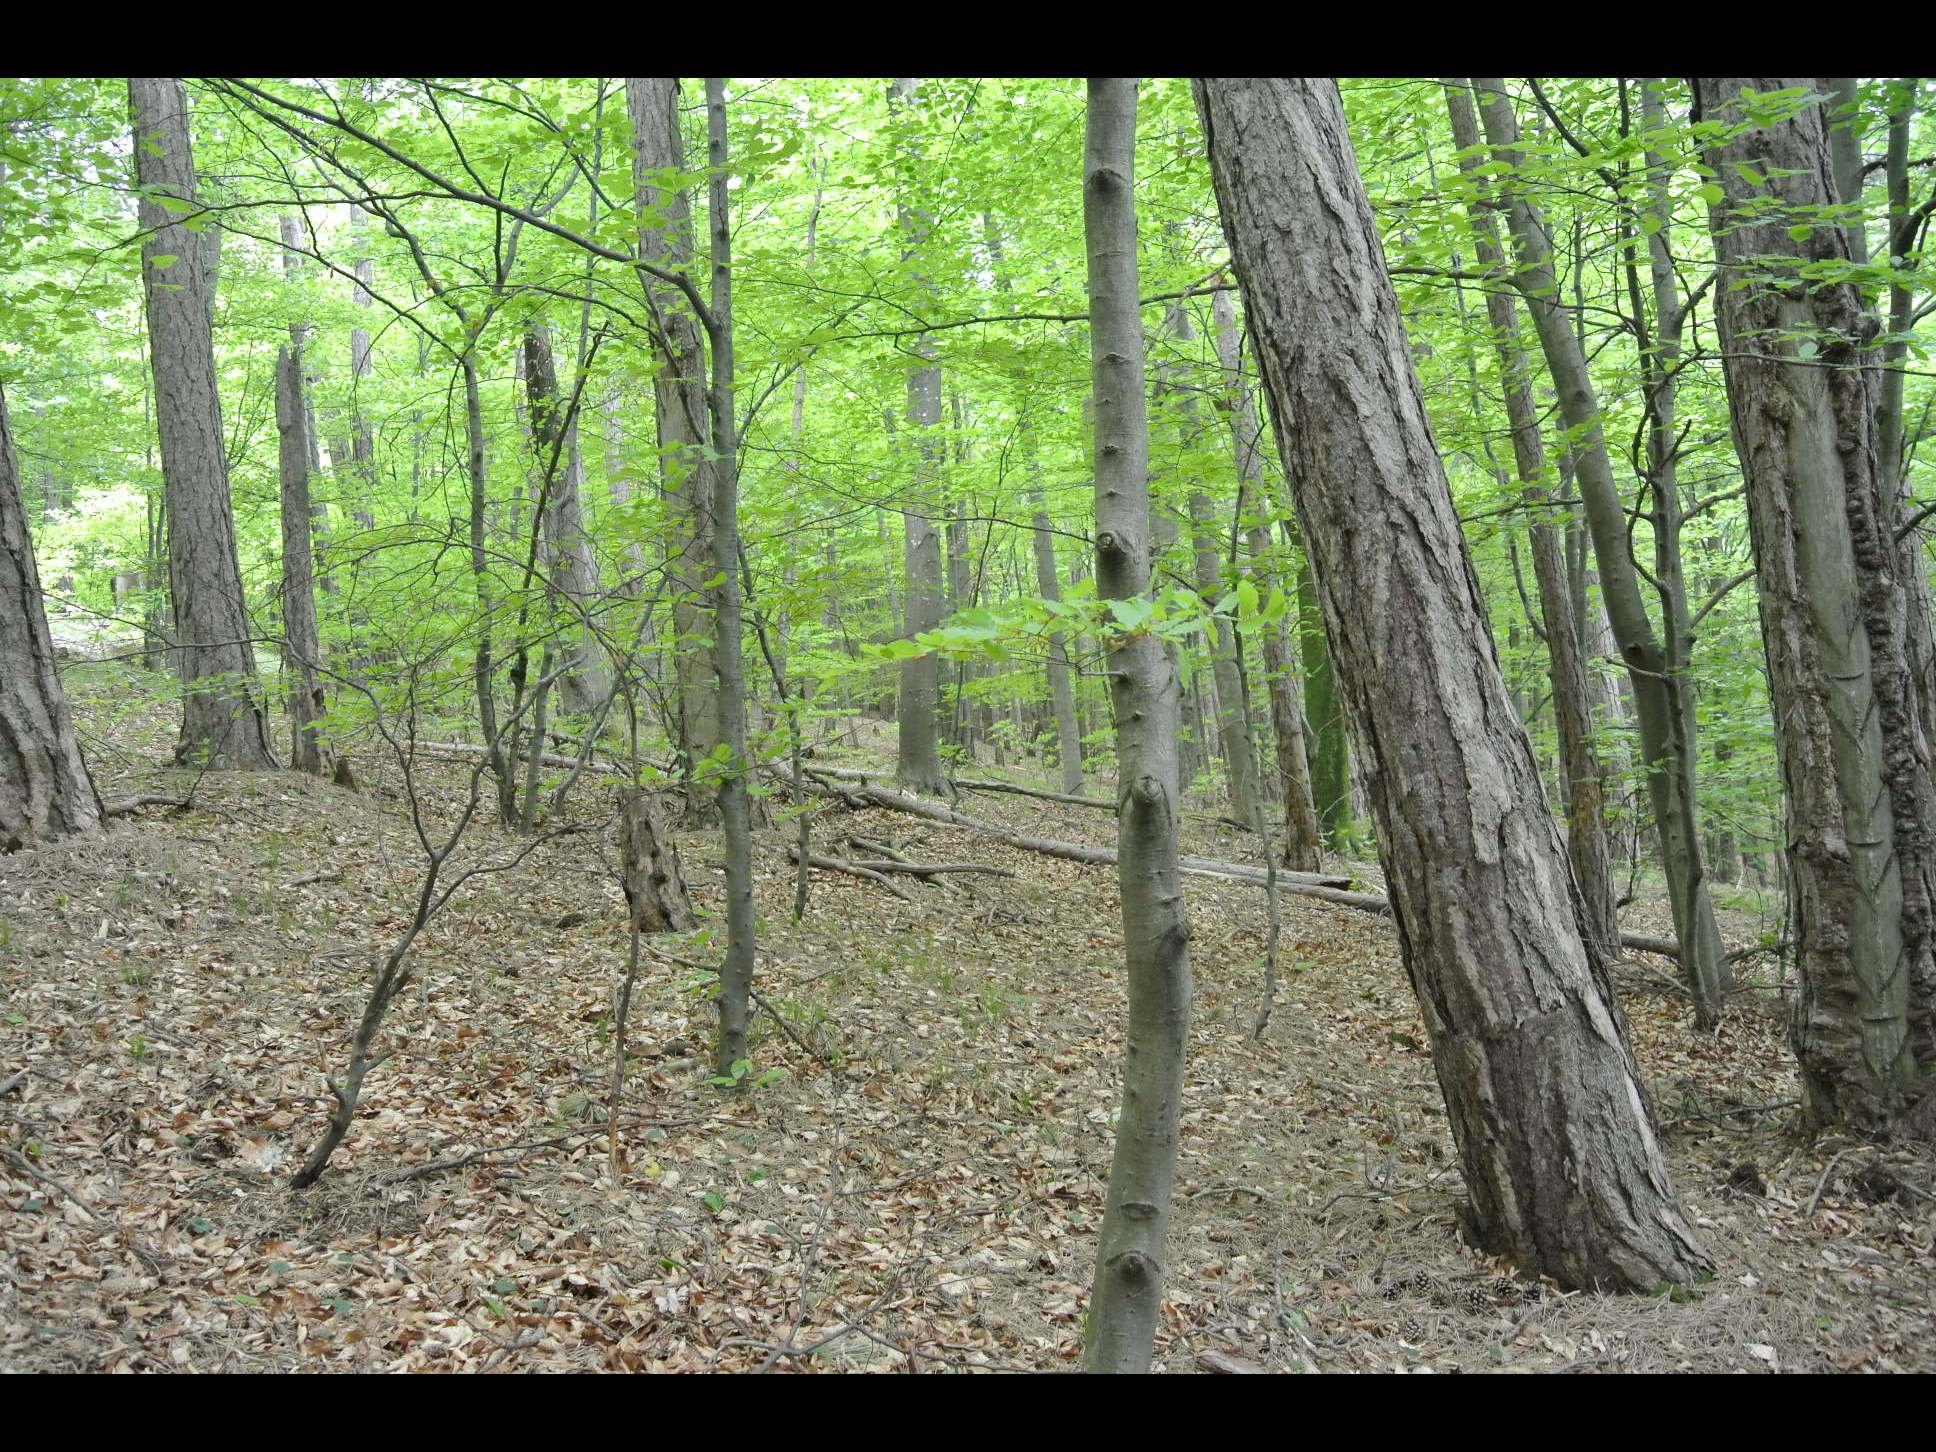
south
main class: Woodland
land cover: Pine dominated mixed woodland
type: alpine coniferous forest
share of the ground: > 75 %
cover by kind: coniferous forest trees 50 %, broadleaved forest trees 50 %
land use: Forestry
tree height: > 5 m
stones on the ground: < 10 %
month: May
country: AT
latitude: 47.9675
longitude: 16.0442
